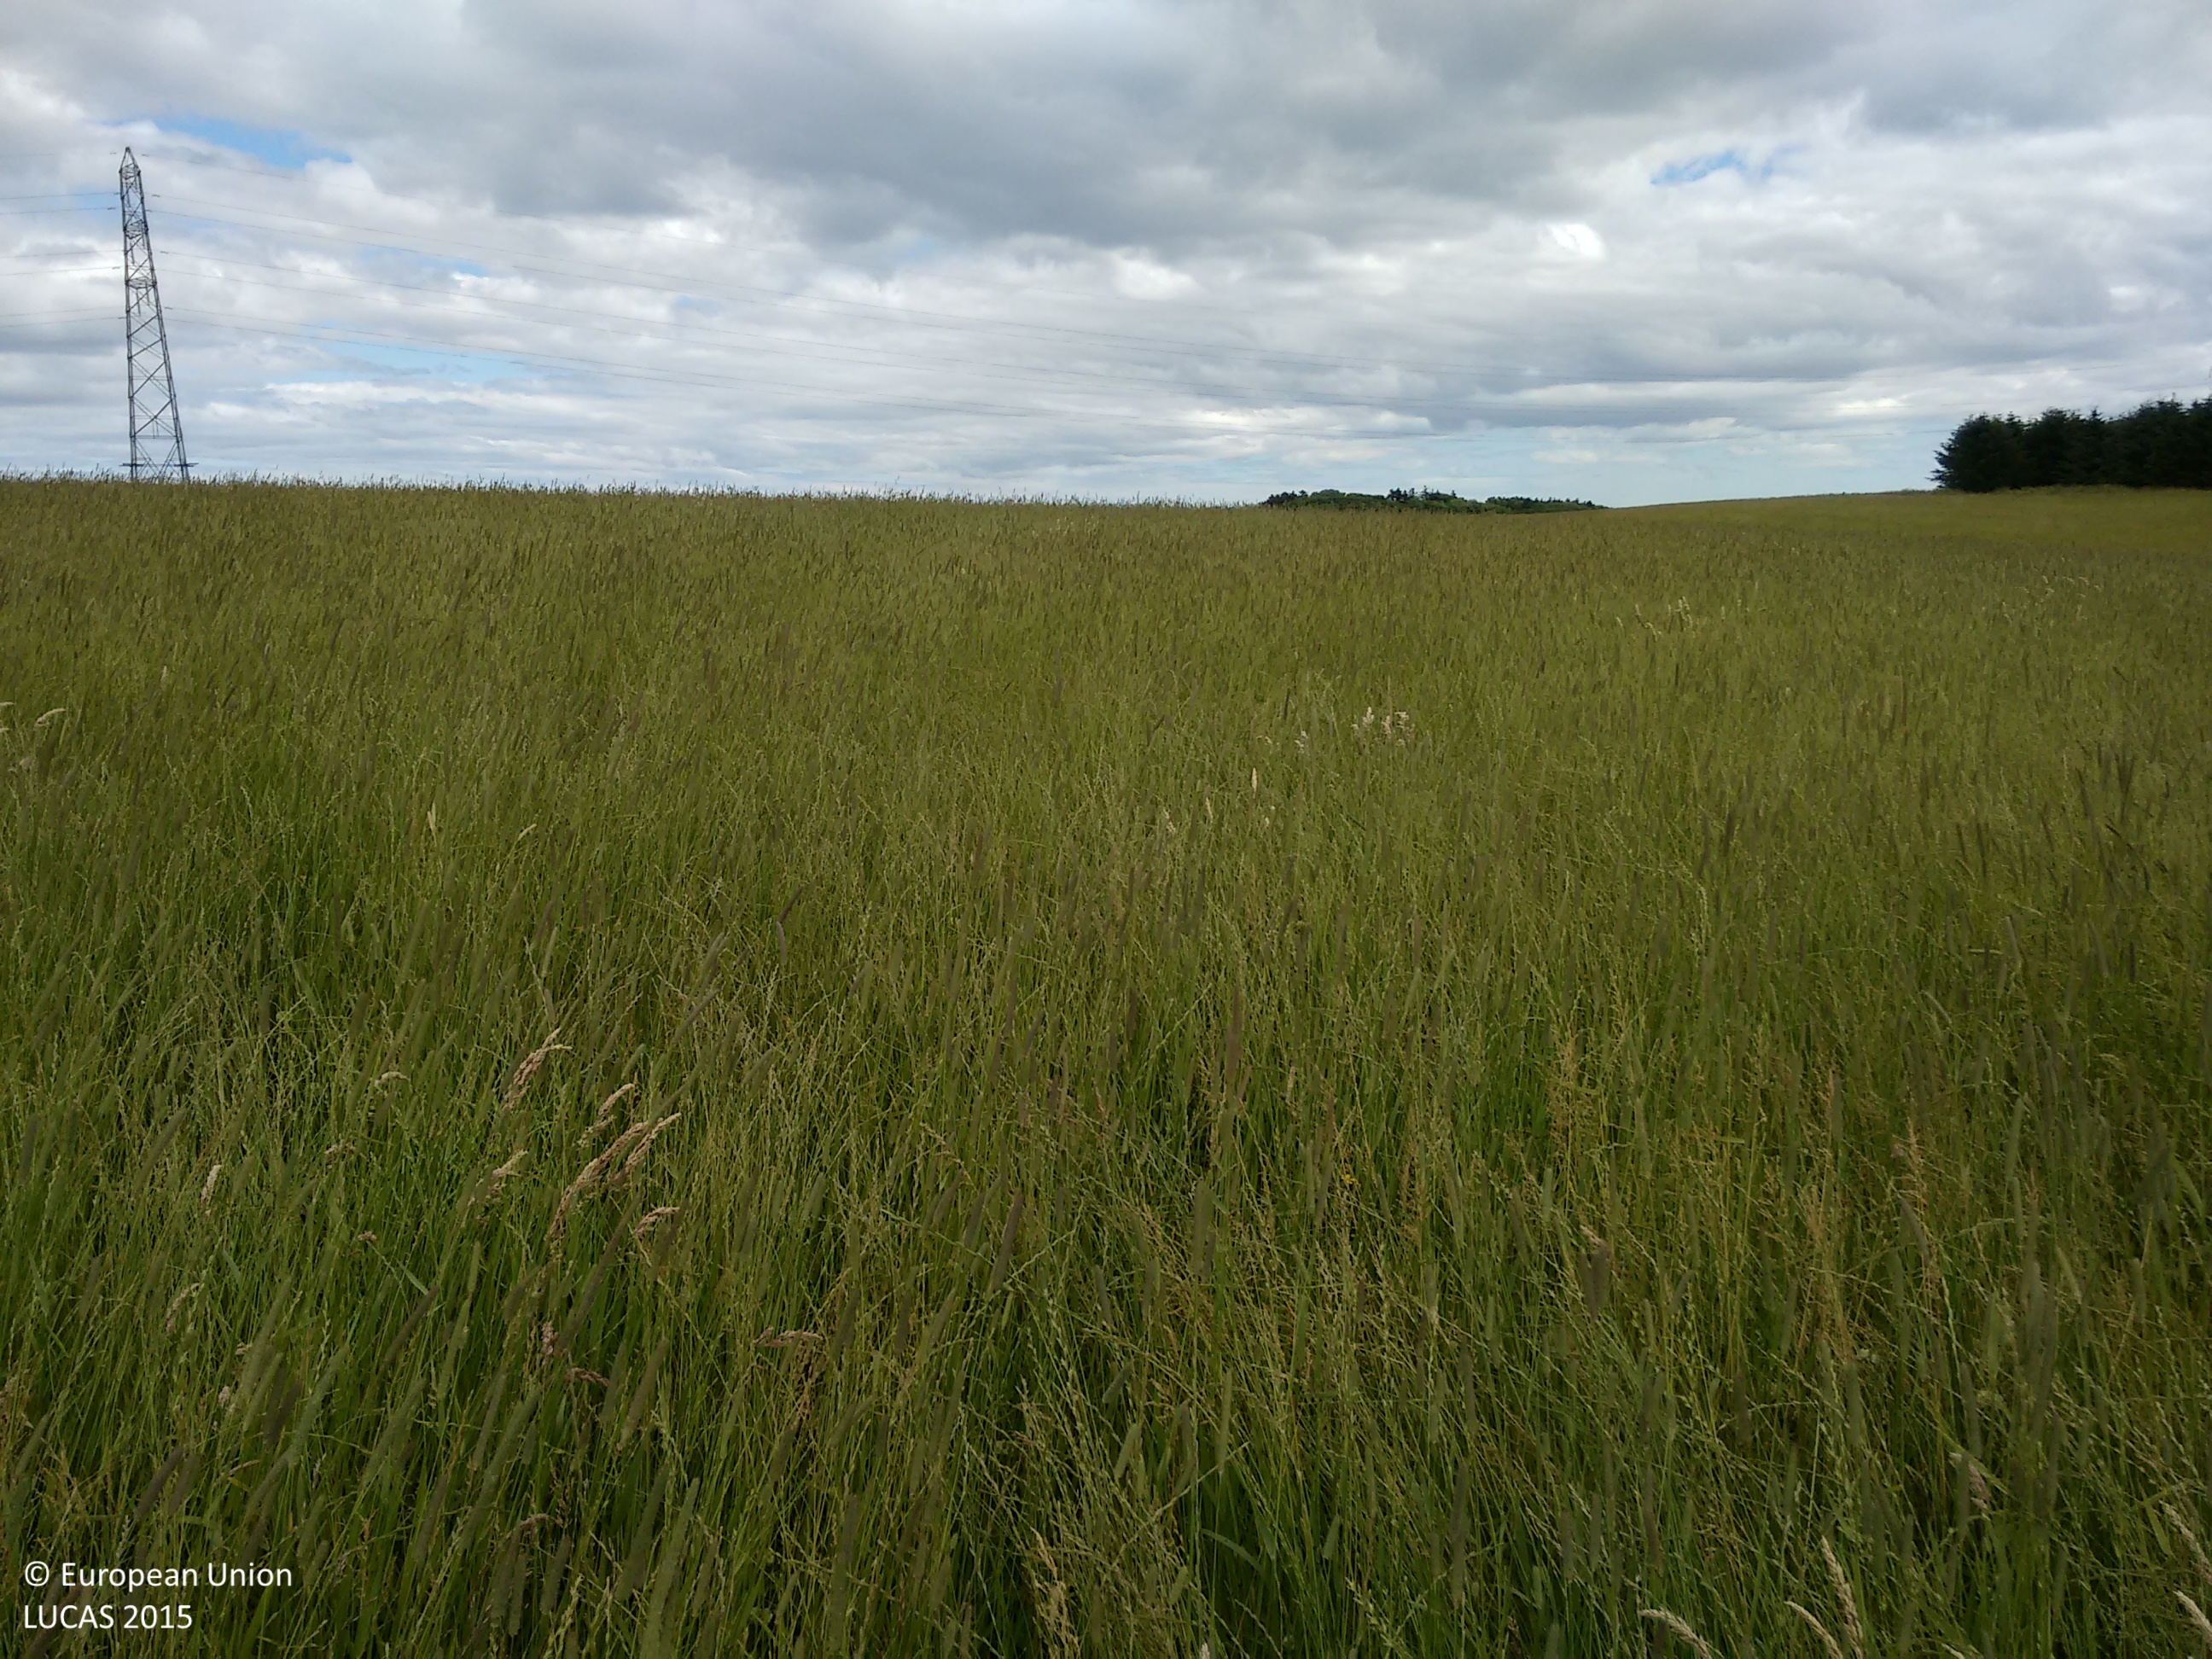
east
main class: Cropland
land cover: Temporary grasslands
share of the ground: > 75 %
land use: Agriculture (excluding fallow land and kitchen gardens)
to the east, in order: Temporary grasslands; Electric lines; Temporary grasslands
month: July
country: GB
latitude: 57.5469
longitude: -1.8557
